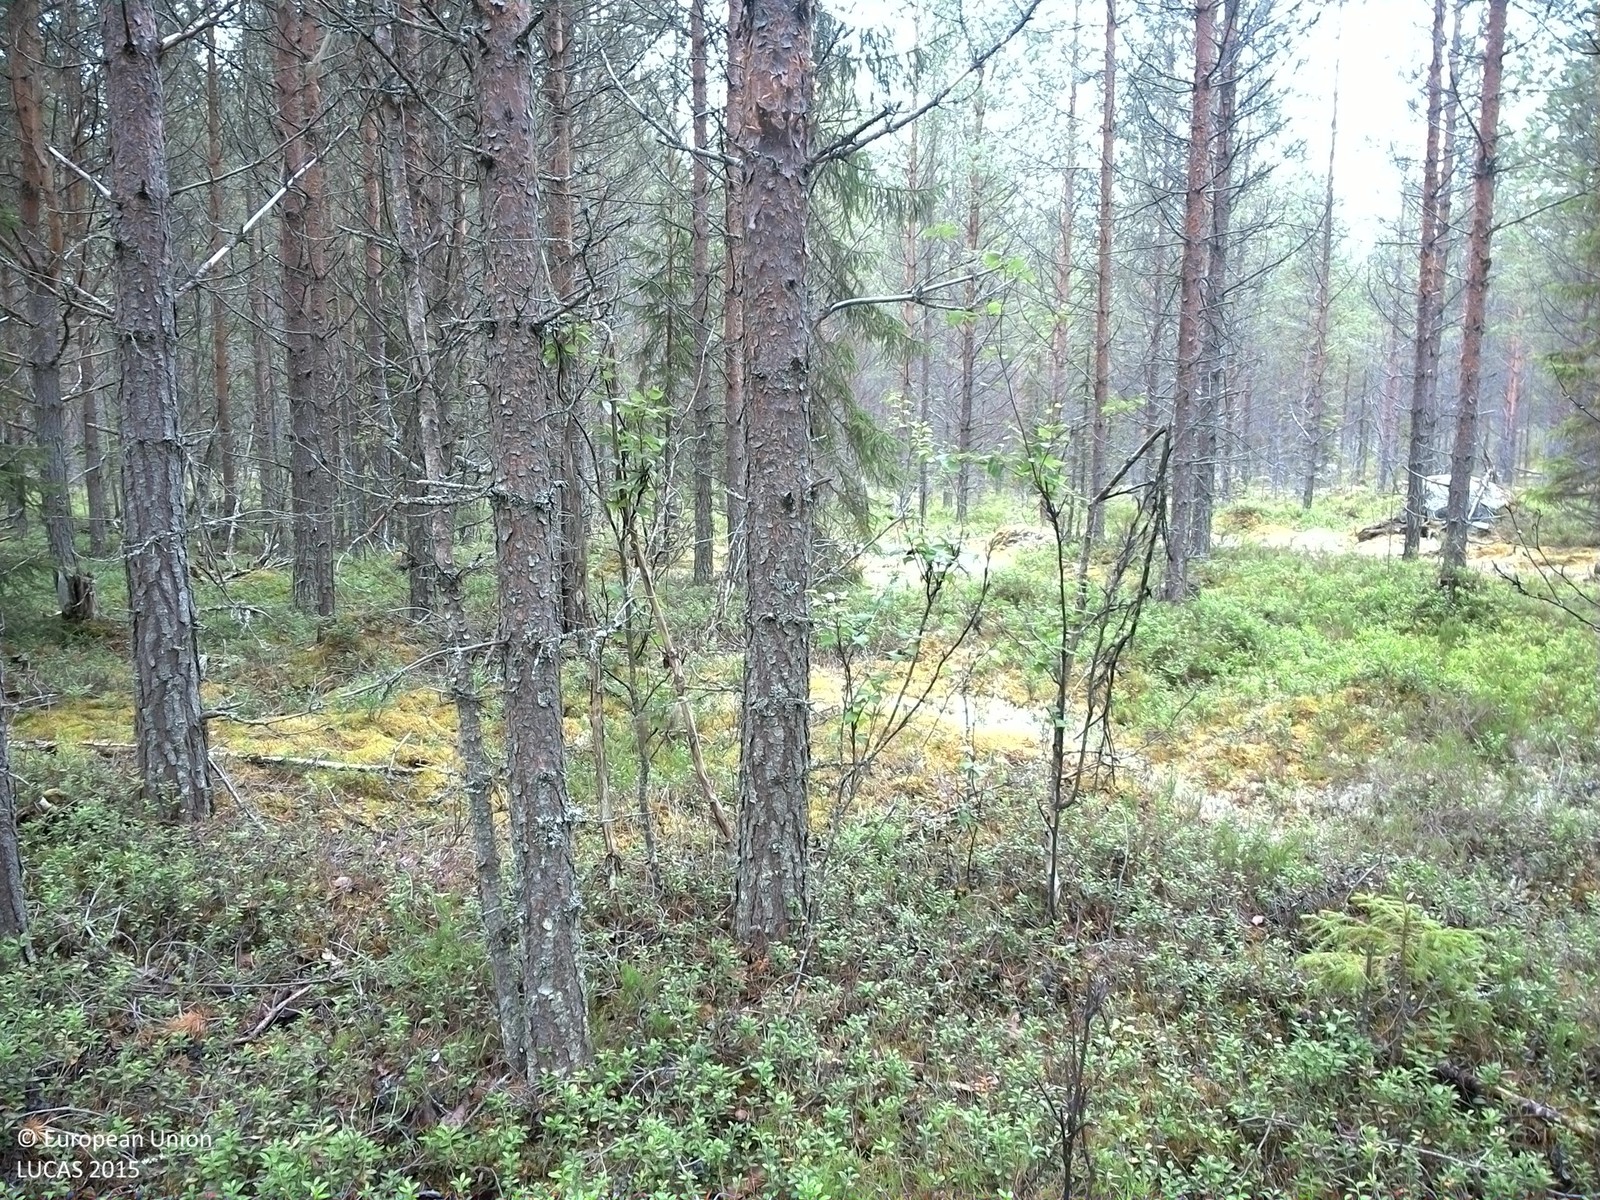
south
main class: Woodland
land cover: Pine dominated coniferous woodland
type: boreal forest
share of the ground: 50 - 75 %
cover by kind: coniferous forest trees 50 %, shrubs 30 %, lichens and mosses 15 %, broadleaved forest trees 5 %
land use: Forestry
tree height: > 5 m
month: July
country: SE
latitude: 63.6050
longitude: 17.0902
